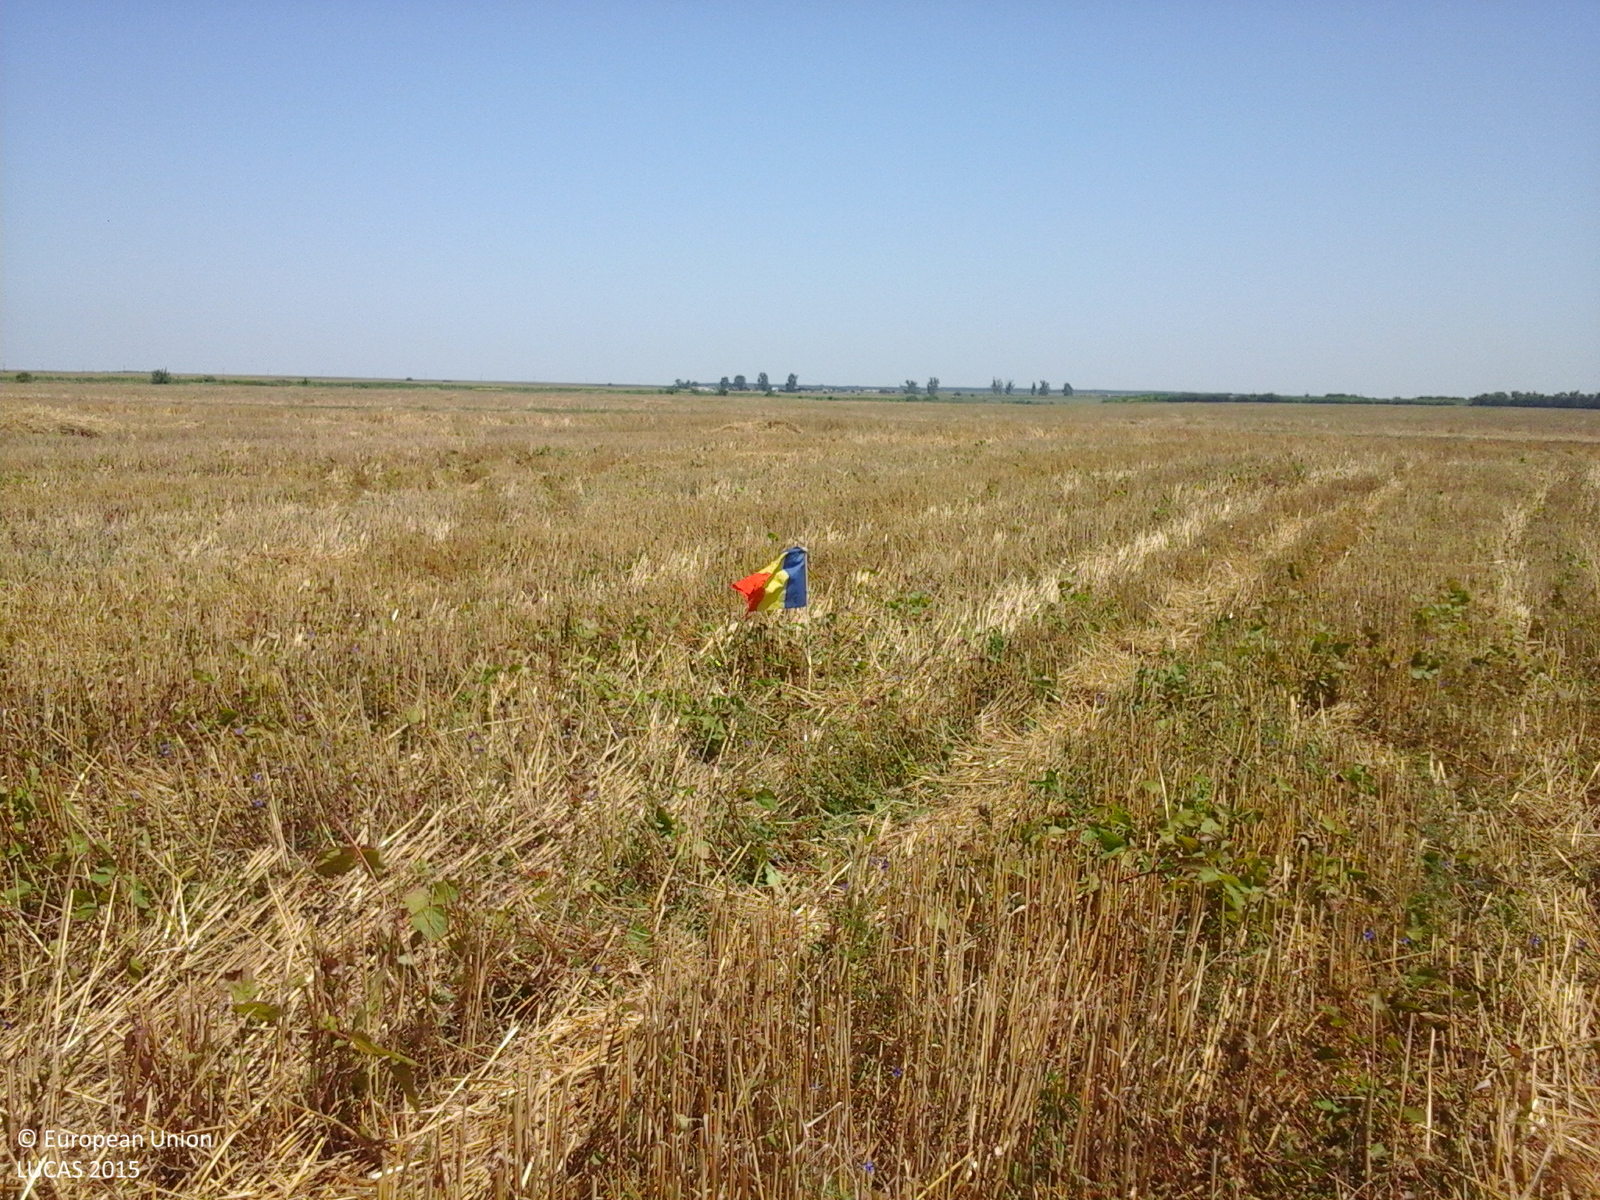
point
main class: Cropland
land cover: Durum wheat
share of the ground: 10 - 25 %
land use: Agriculture (excluding fallow land and kitchen gardens)
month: July
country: RO
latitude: 44.2762
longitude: 26.5657
